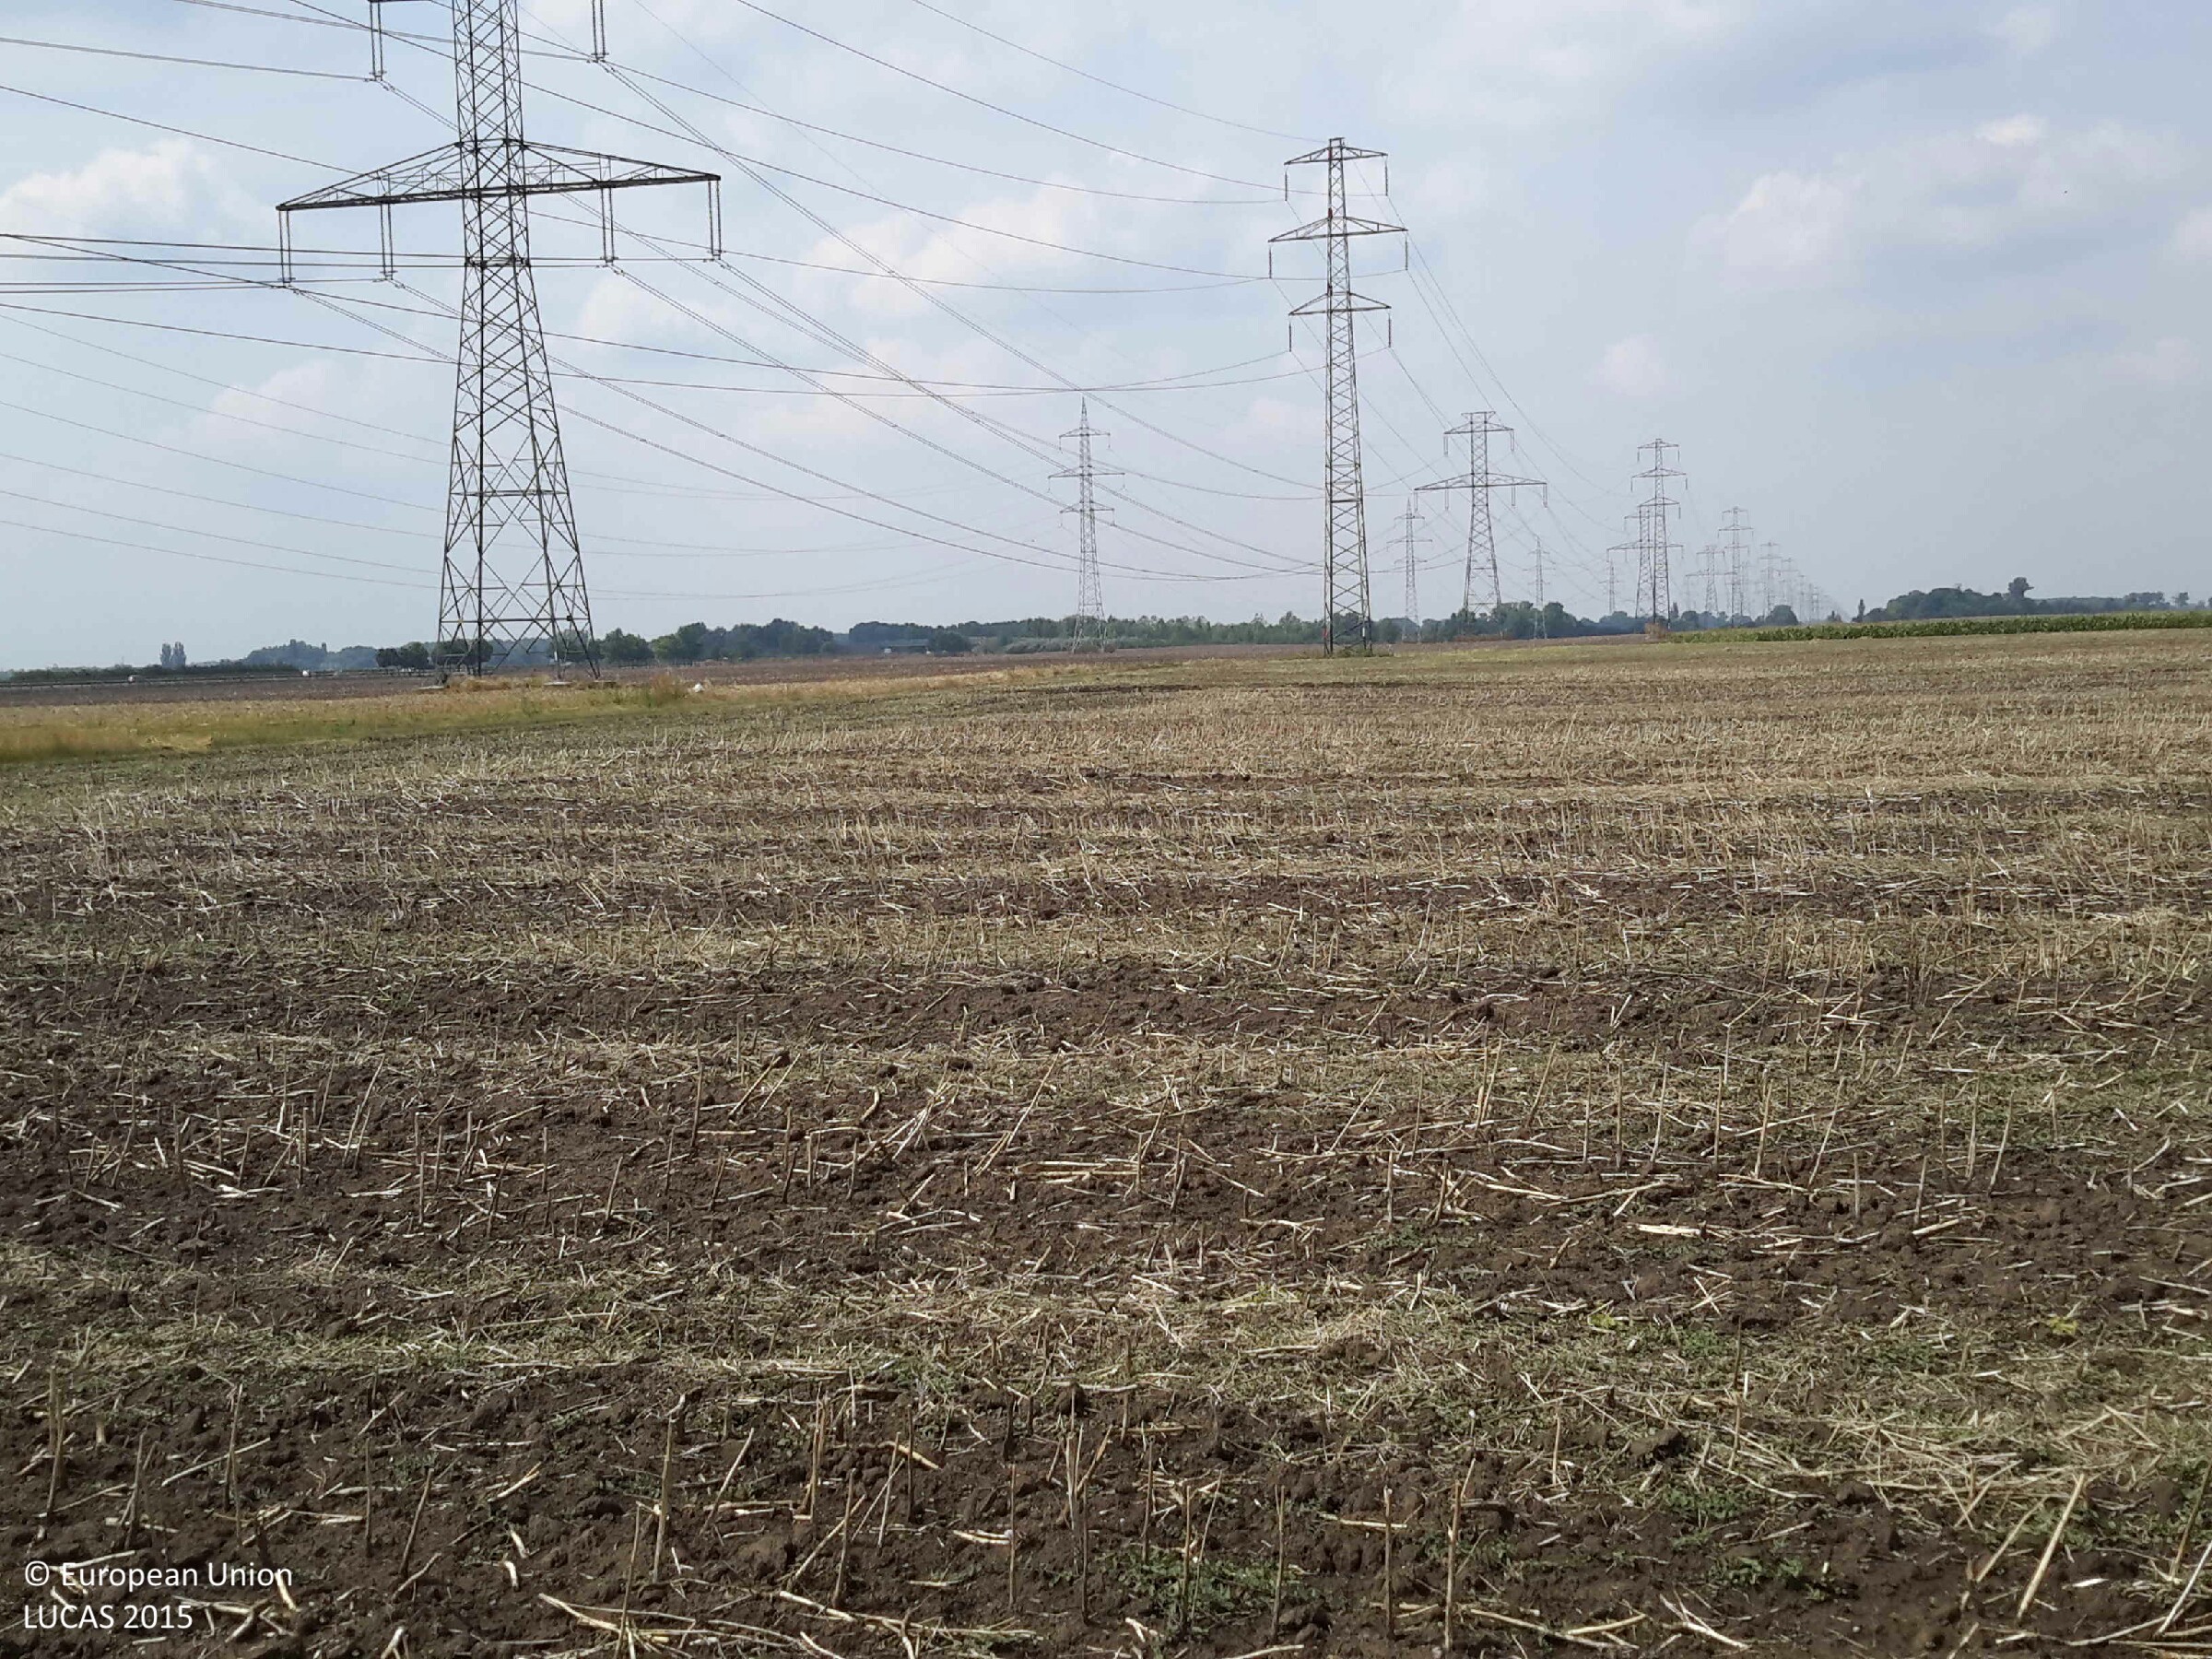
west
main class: Cropland
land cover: Rape and turnip rape
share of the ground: < 10 %
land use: Agriculture (excluding fallow land and kitchen gardens)
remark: Harvested field
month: August
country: HU
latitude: 47.7570
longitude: 17.4122
